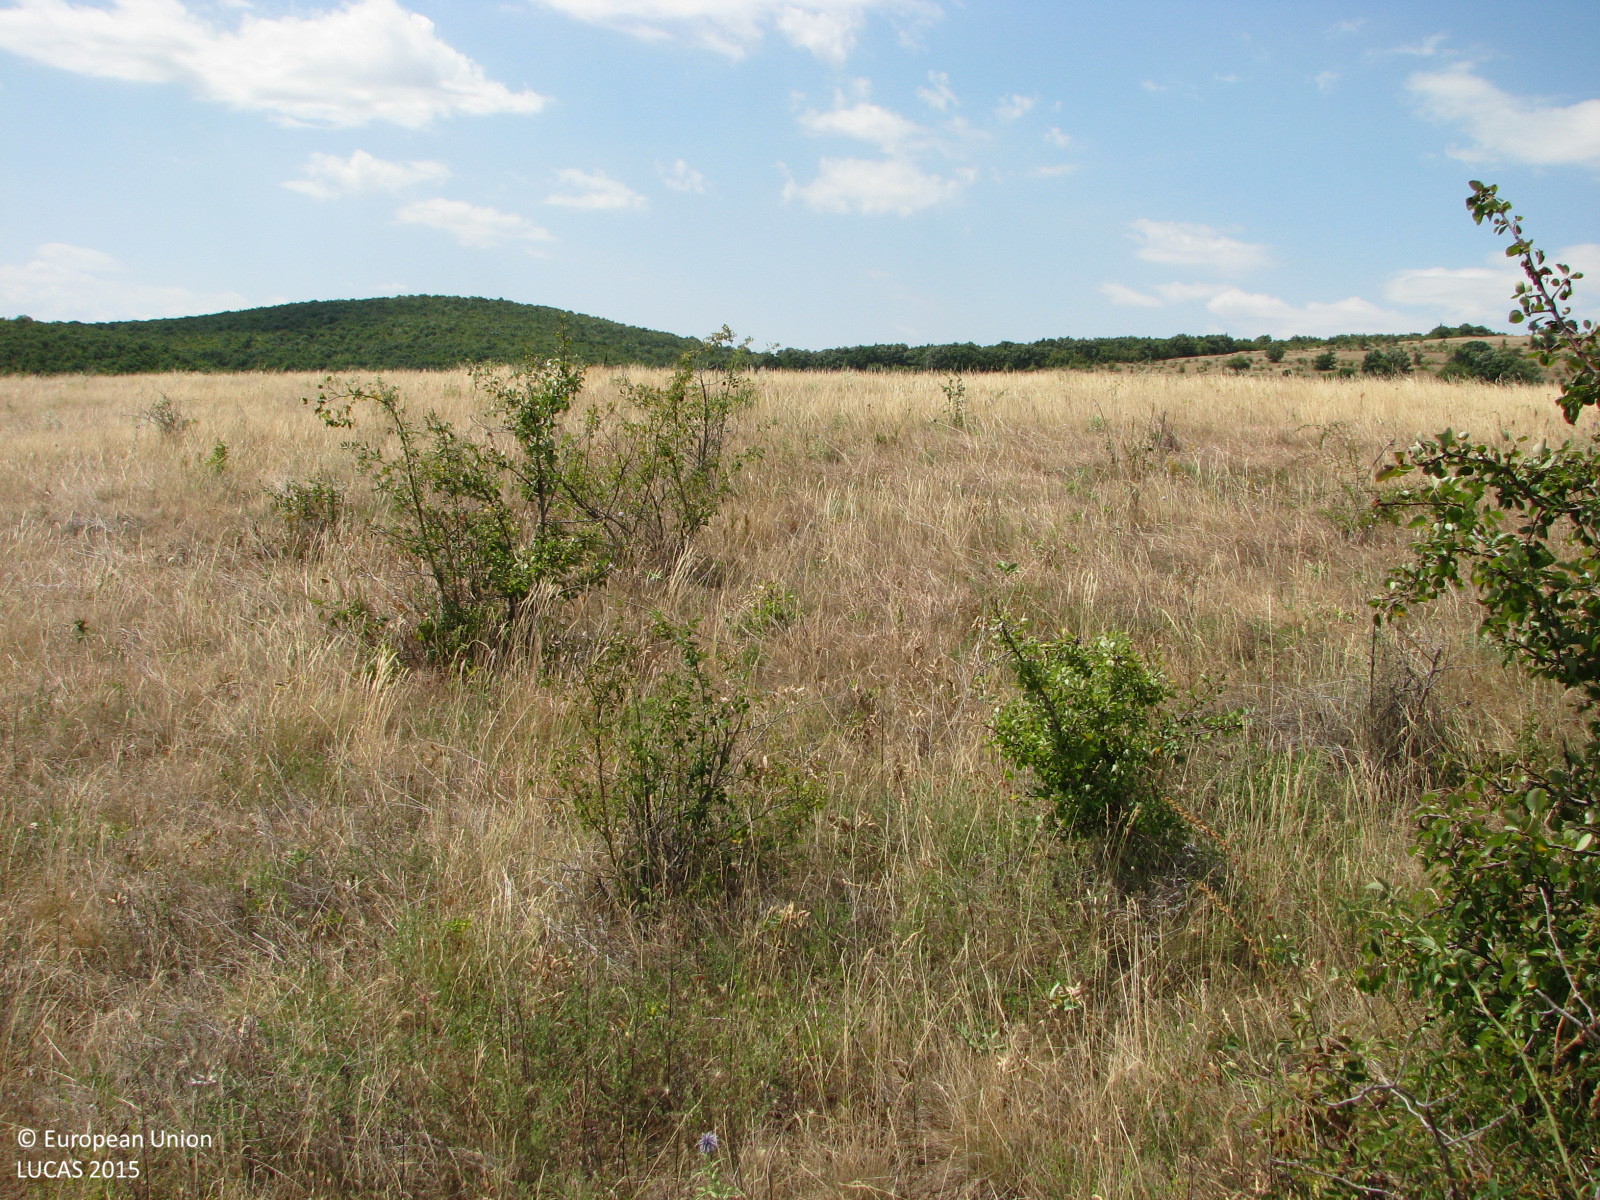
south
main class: Shrubland
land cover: Shrubland without tree cover
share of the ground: 10 - 25 %
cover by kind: herbaceous plants 80 %, shrubs 20 %
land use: Agriculture (excluding fallow land and kitchen gardens)
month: August
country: BG
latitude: 42.6877
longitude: 26.6109
